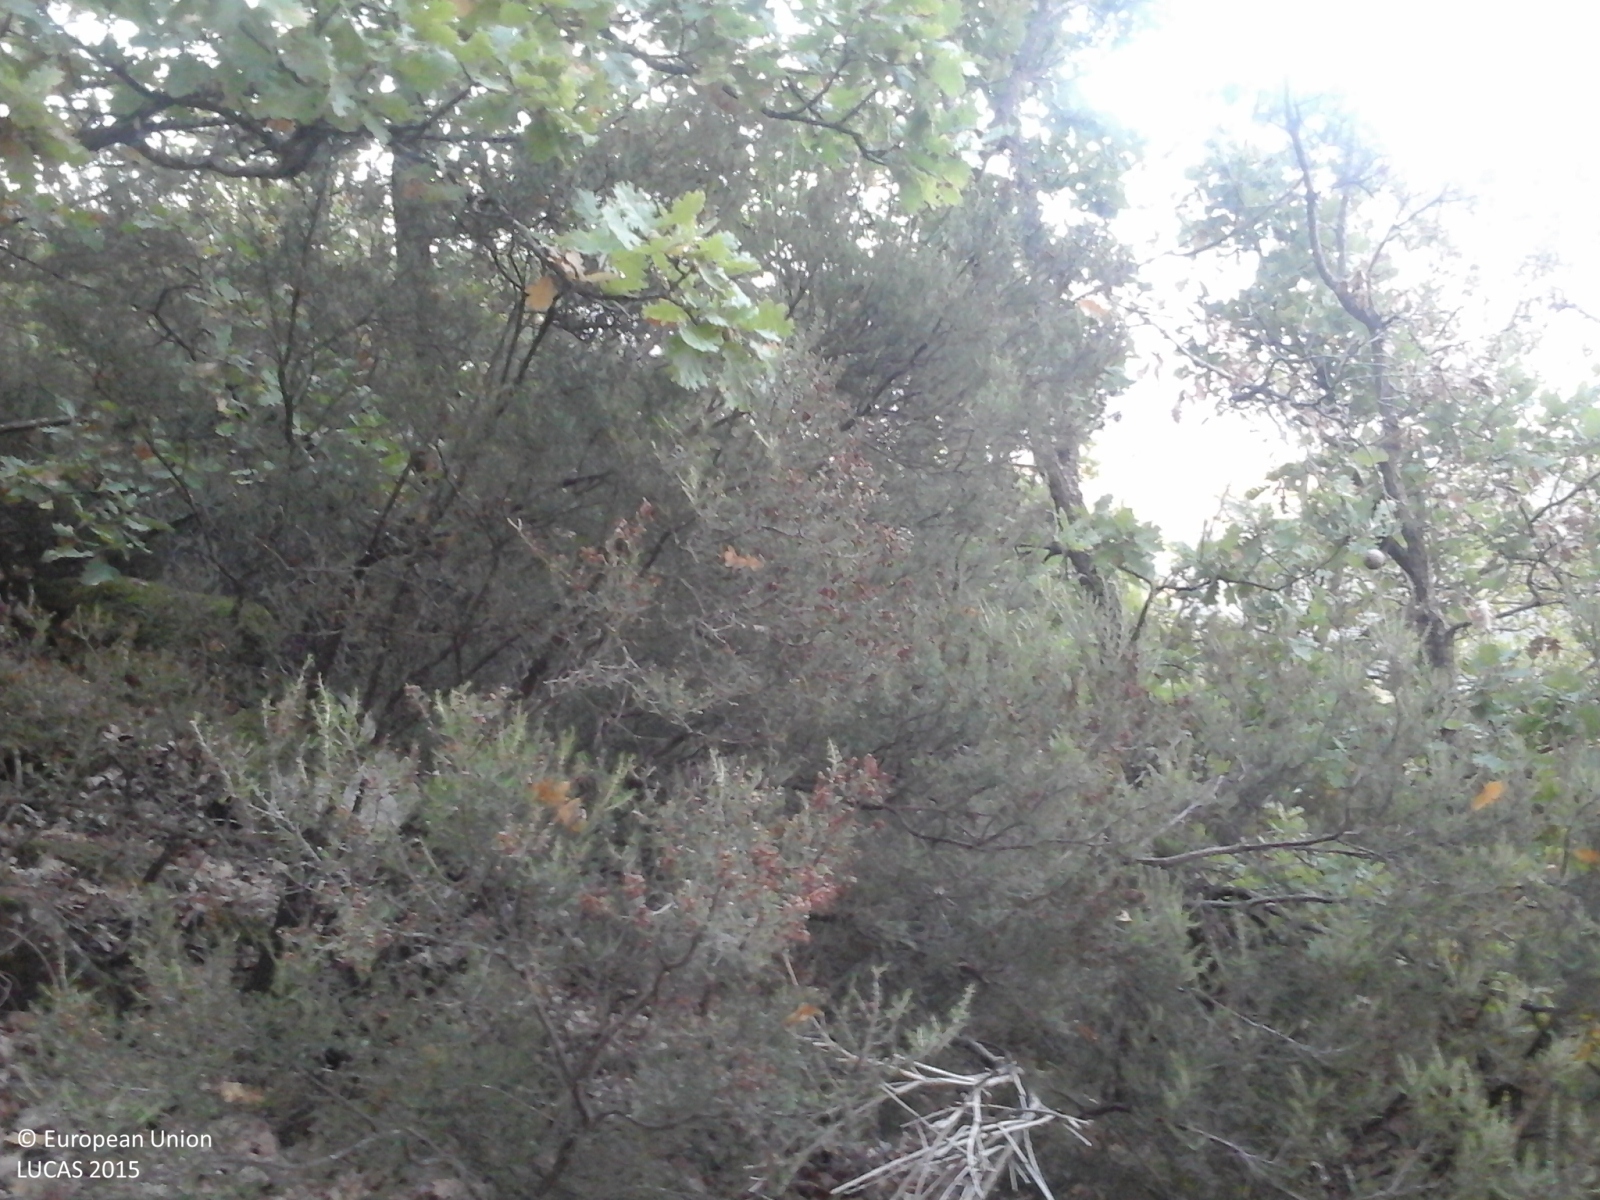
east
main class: Woodland
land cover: Broadleaved woodland
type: thermophilous deciduous forest
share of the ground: > 75 %
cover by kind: broadleaved forest trees 95 %, shrubs 5 %
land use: Semi-natural and natural areas not in use
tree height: > 5 m
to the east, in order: Broadleaved woodland; Tracks; Broadleaved woodland
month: October
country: IT
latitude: 43.3732
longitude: 12.0800
